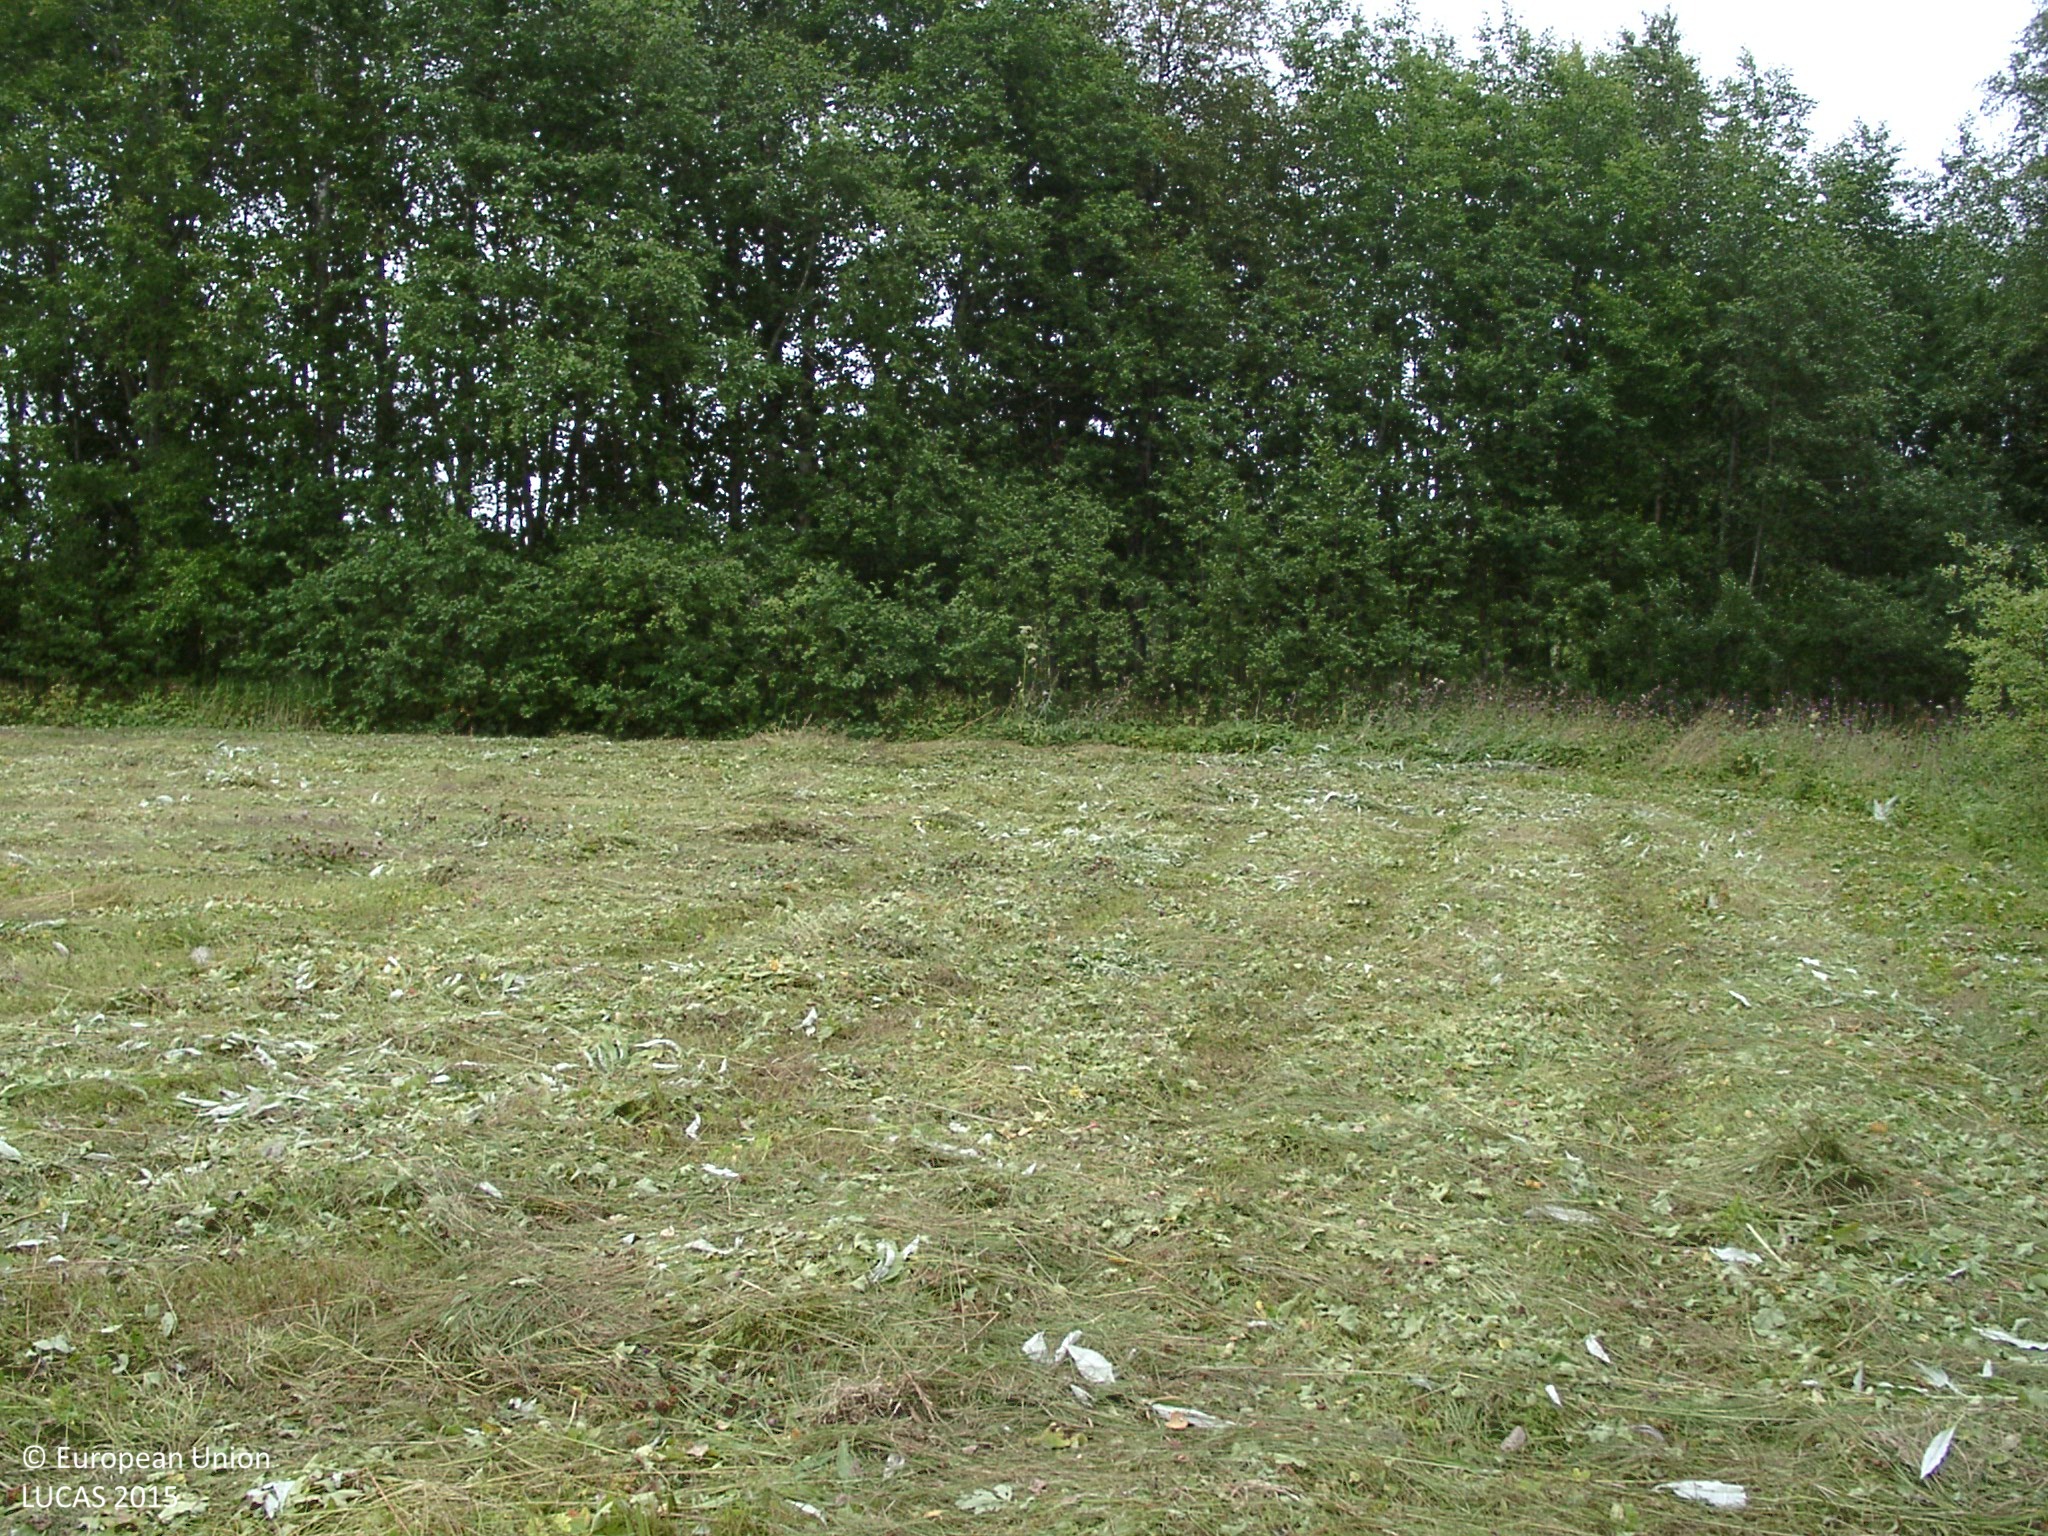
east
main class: Grassland
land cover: Spontaneously vegetated surfaces
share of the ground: > 75 %
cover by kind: herbaceous plants 100 %
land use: Fallow land
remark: Harvested field
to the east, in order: Spontaneously vegetated surfaces; Groves; Ditches and canals; Broadleaved woodland; Ditches and canals; Groves; Rape and turnip rape; Other non-permanent industrial crops; Shruby margins; Ditches and canals; Broadleaved woodland; Spruce dominated coniferous woodland; Ditches and canals; Spruce dominated coniferous woodland; Grass margins; Ditches and canals; Grass margins; Spruce dominated coniferous woodland; Tracks; Spruce dominated coniferous woodland; Broadleaved woodland; Grassland without tree/shrub cover
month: August
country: FI
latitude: 62.6898
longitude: 24.5660
